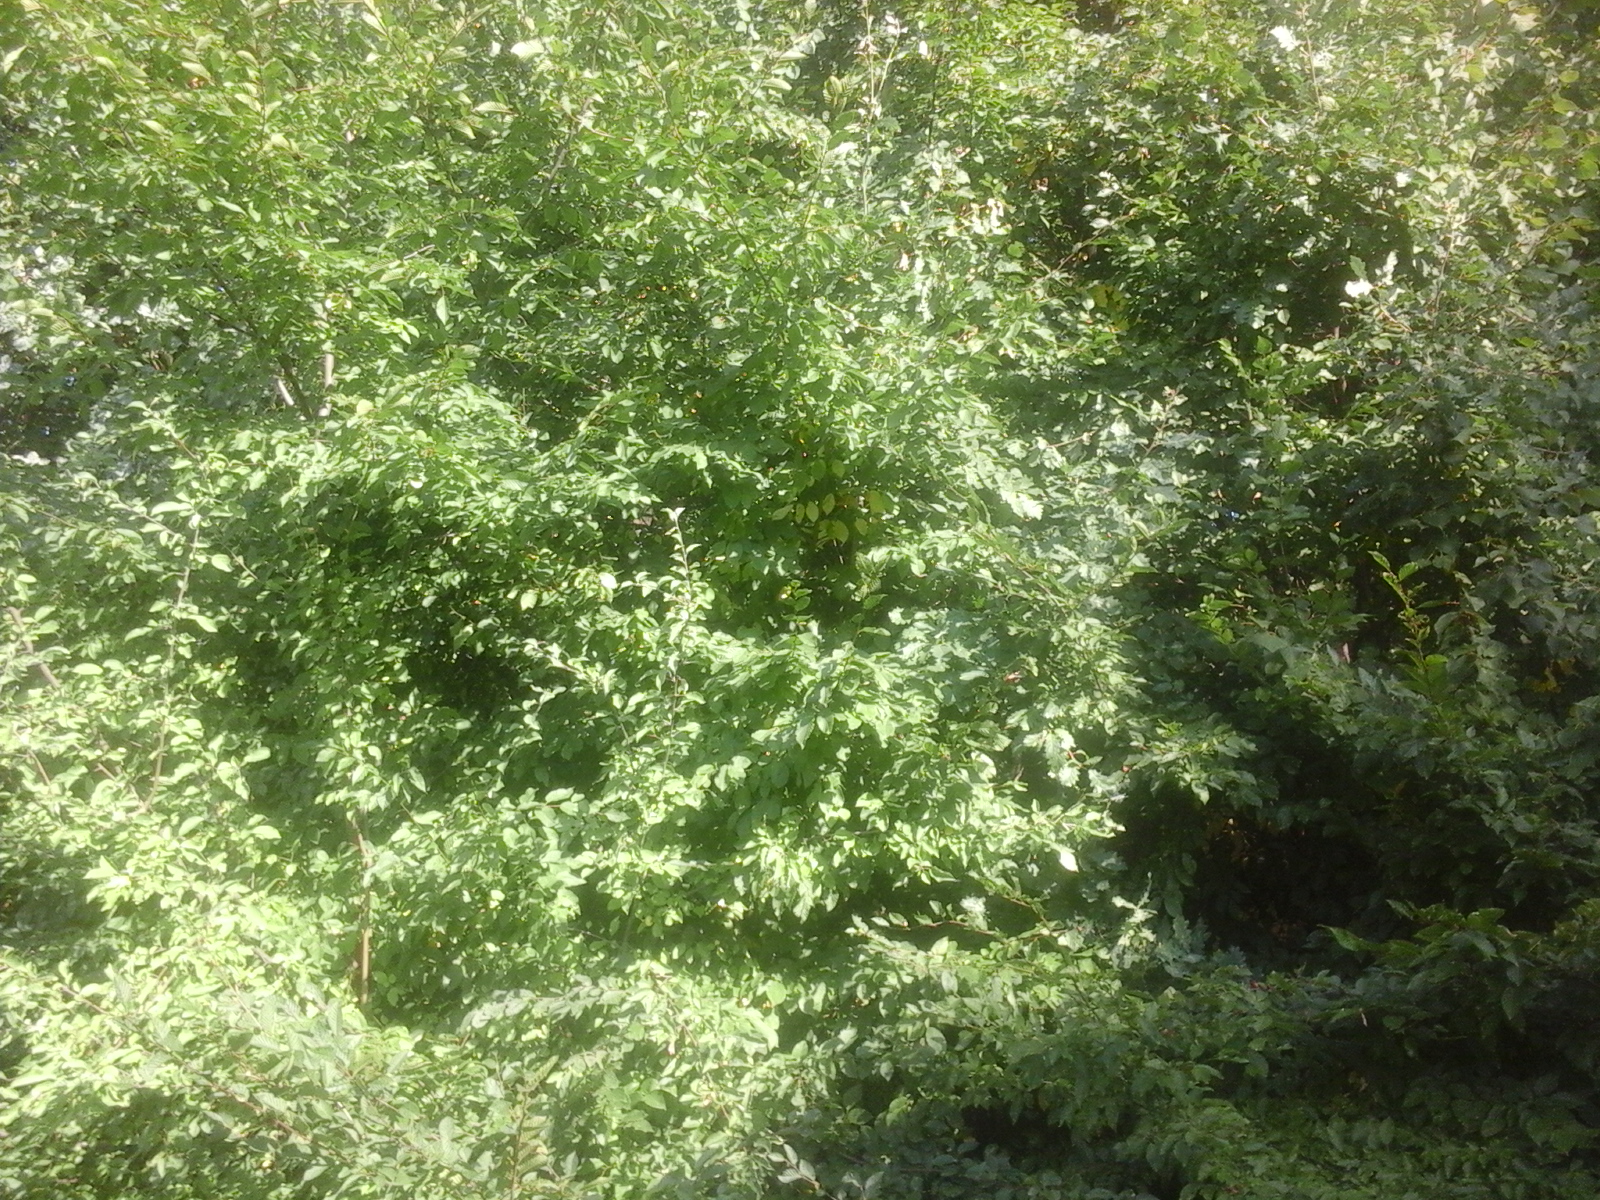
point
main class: Woodland
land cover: Broadleaved woodland
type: beech forest
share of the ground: > 75 %
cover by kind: broadleaved forest trees 100 %
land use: Forestry
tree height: > 5 m
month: September
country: RO
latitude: 47.1128
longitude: 24.4953
